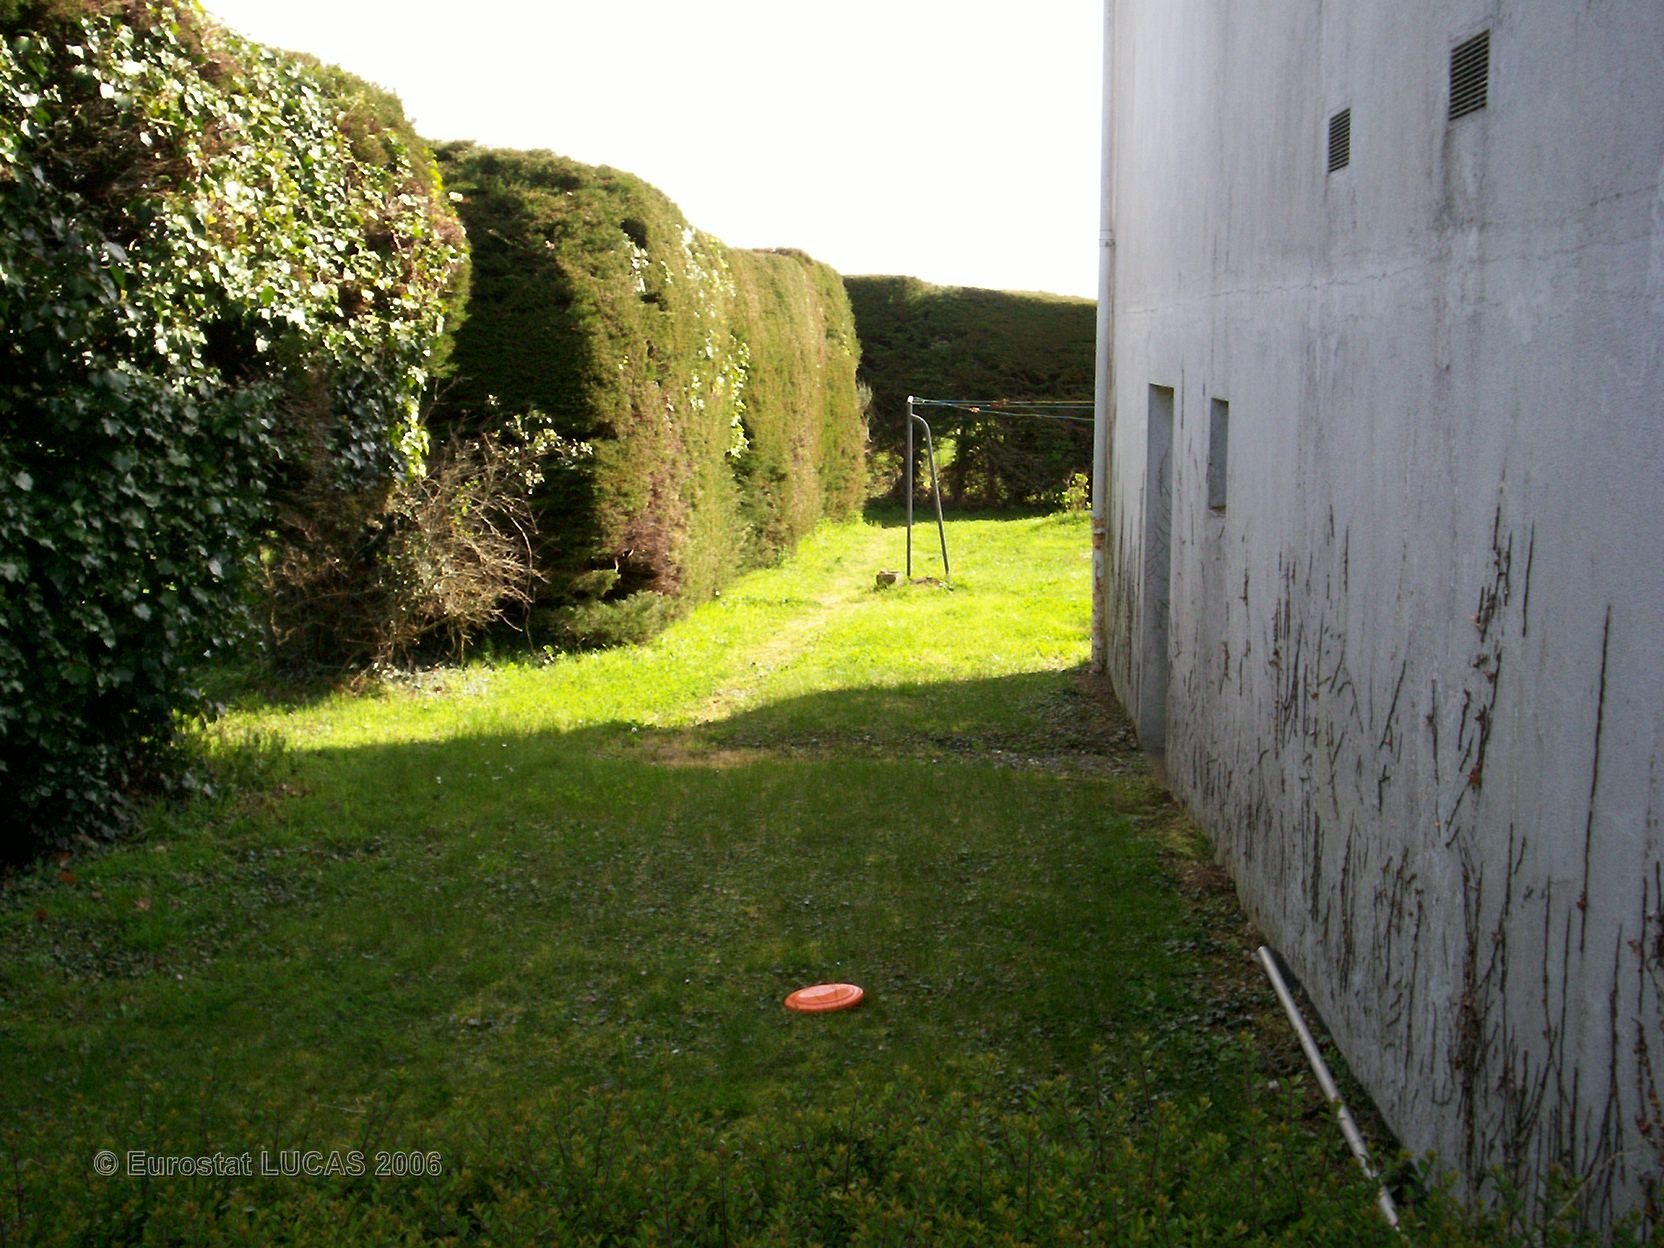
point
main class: Grassland
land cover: Grassland without tree/shrub cover
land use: Residential
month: April
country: FR
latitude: 47.7059
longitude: -3.4411
